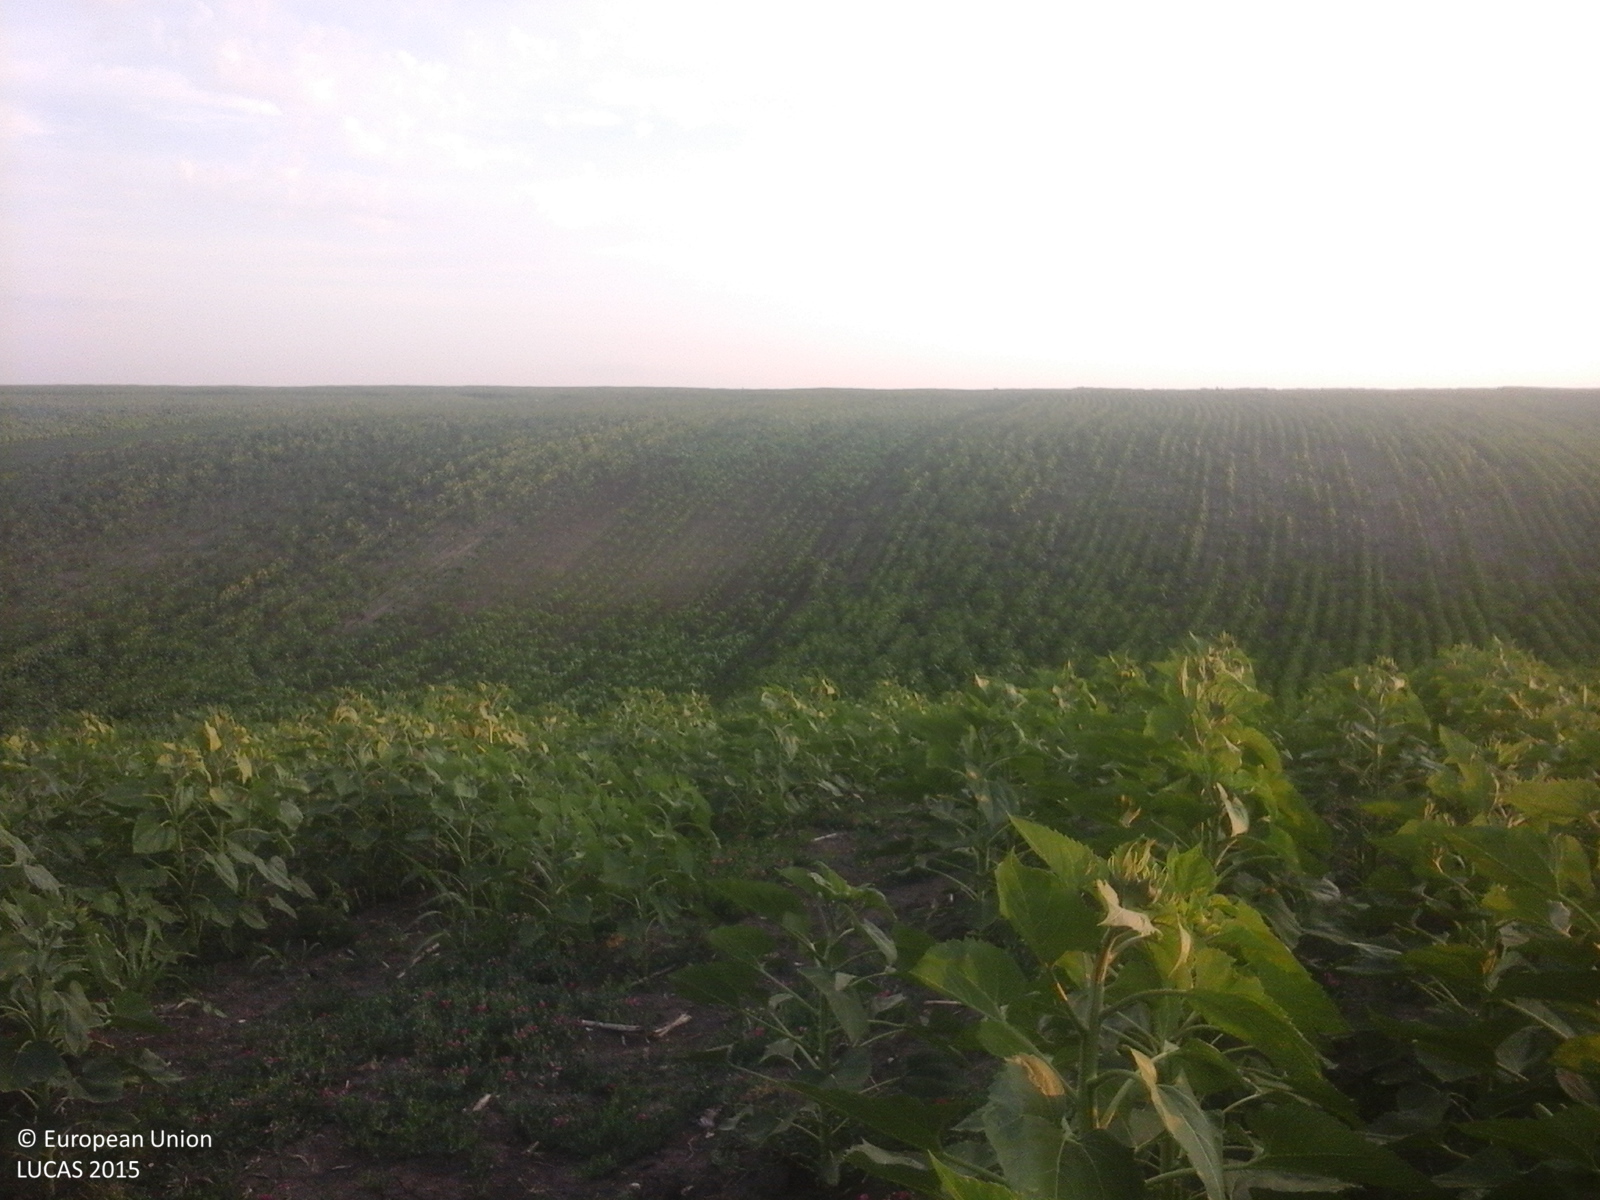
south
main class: Cropland
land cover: Sunflower
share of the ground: > 75 %
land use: Agriculture (excluding fallow land and kitchen gardens)
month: June
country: RO
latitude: 46.7876
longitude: 27.7391
